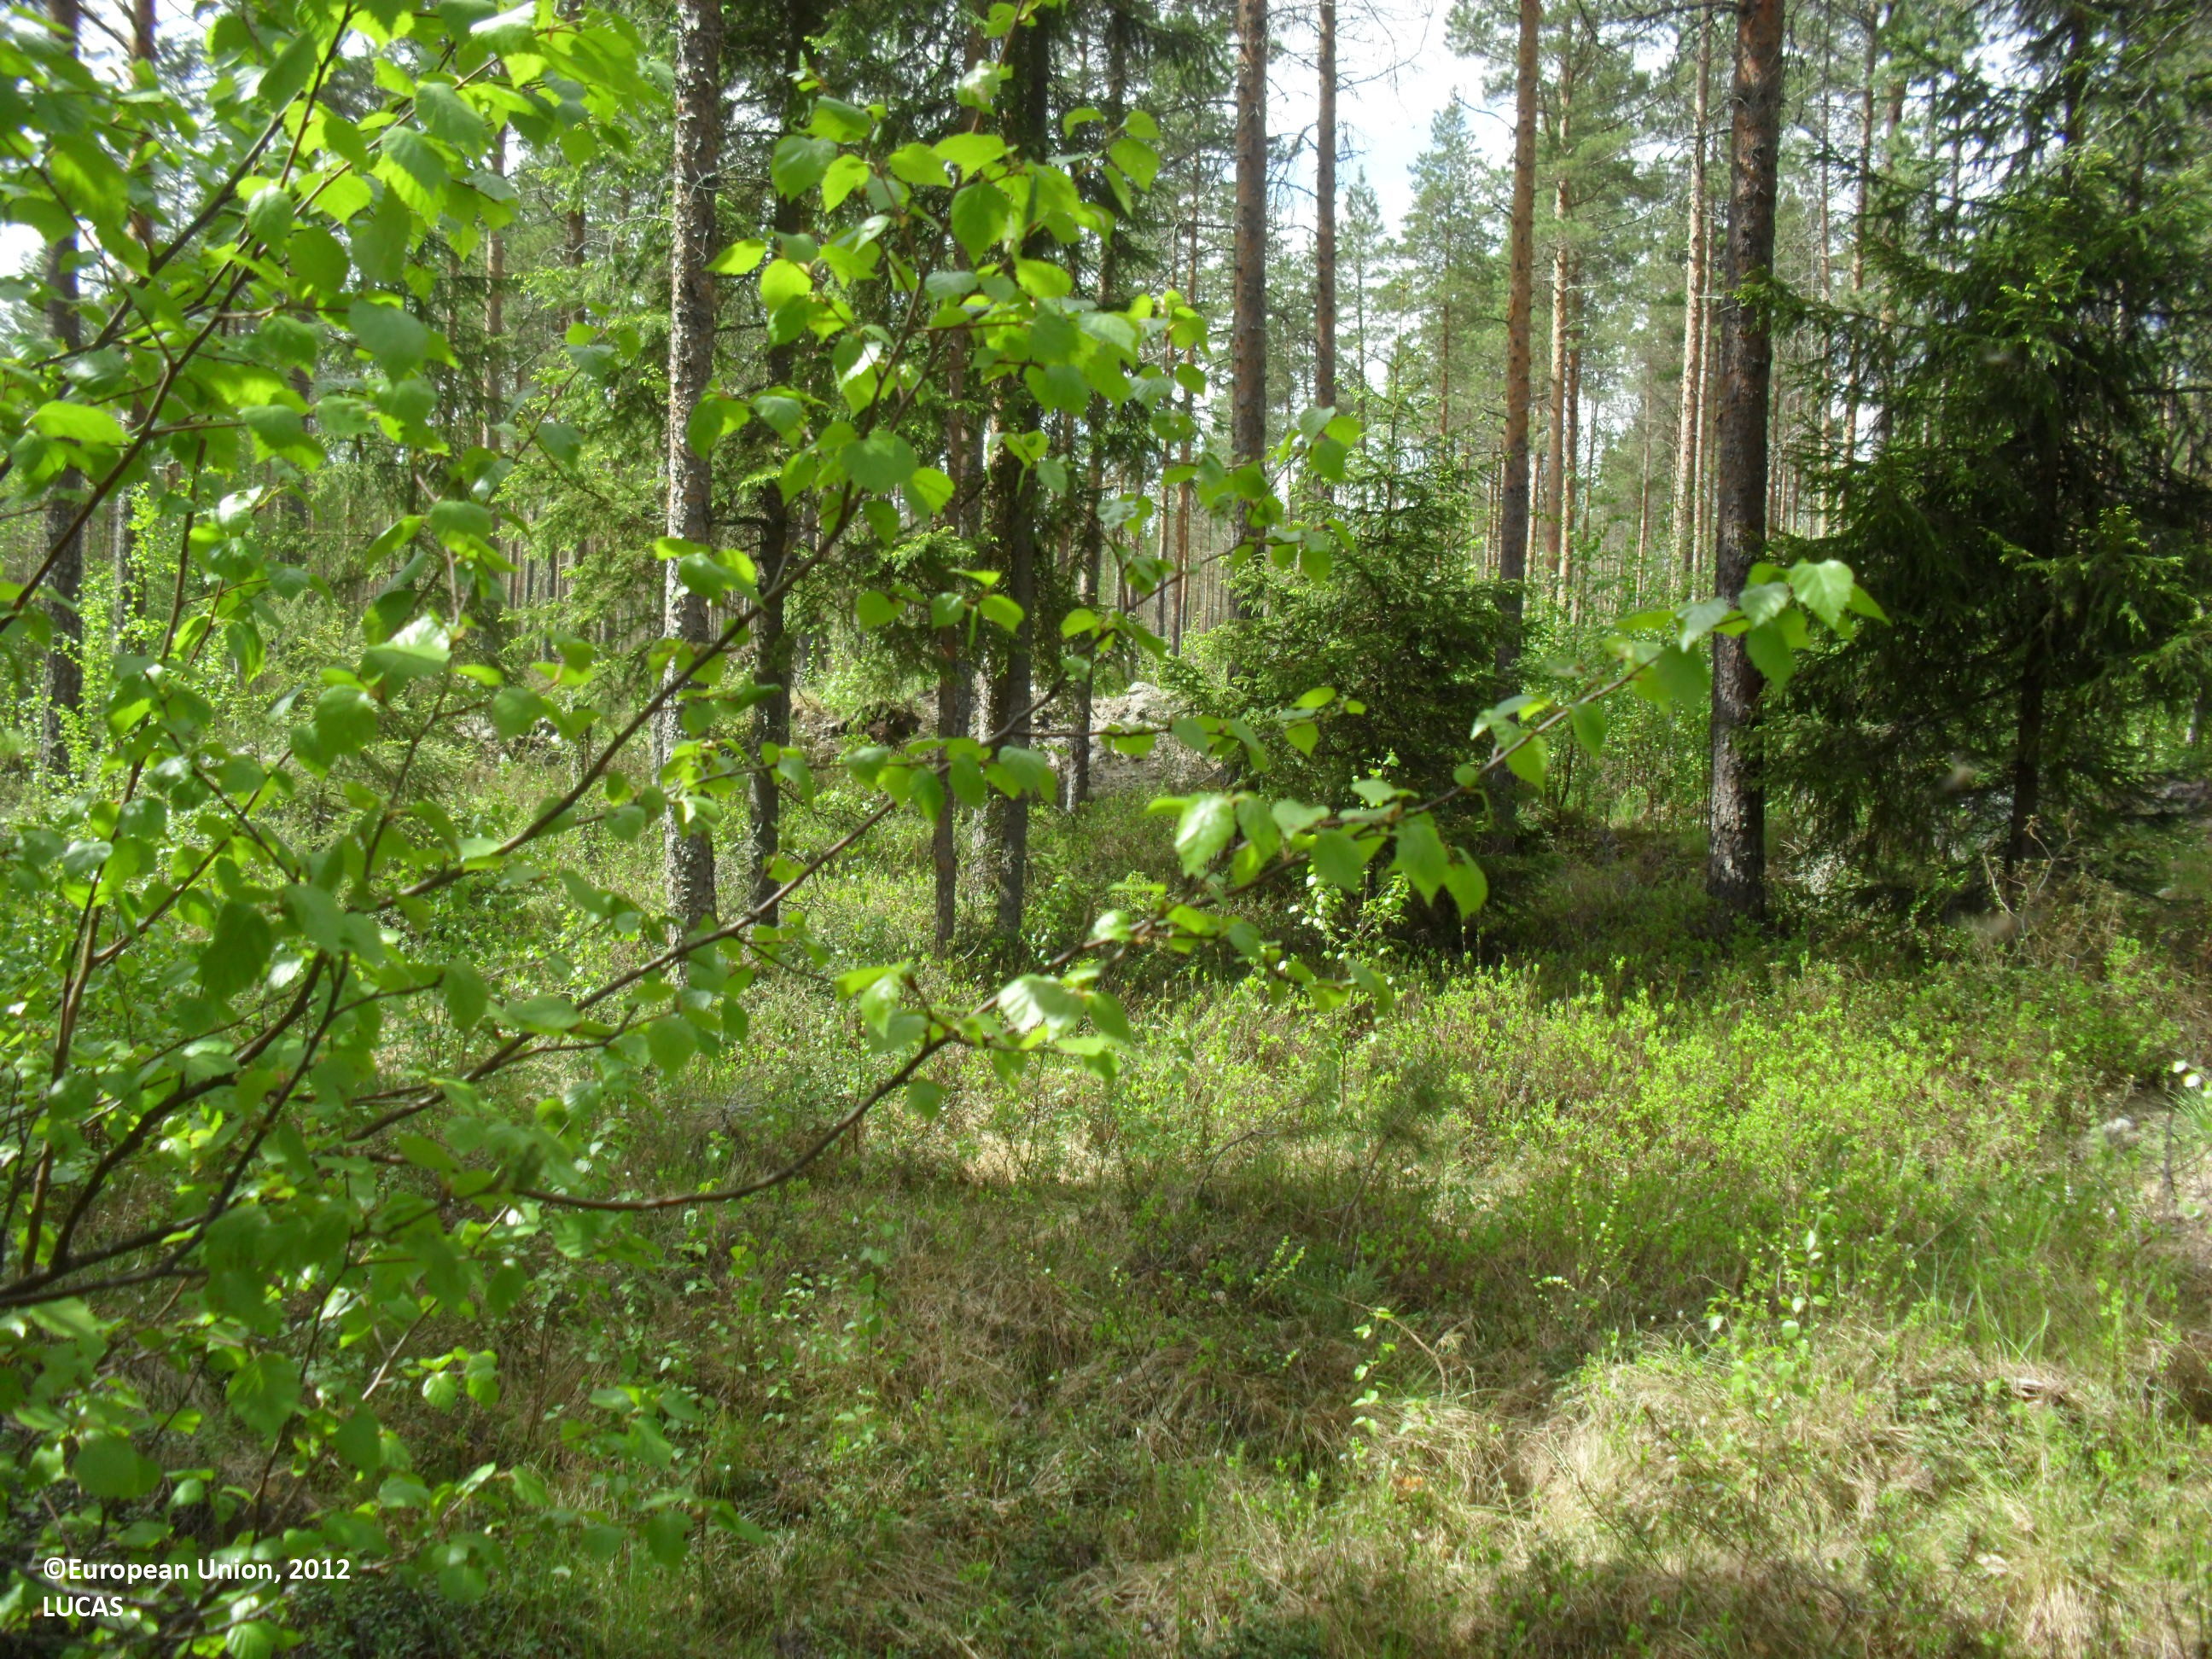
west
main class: Woodland
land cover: Pine dominated coniferous woodland
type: boreal forest
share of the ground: 50 - 75 %
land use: Forestry
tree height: > 5 m
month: June
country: FI
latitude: 63.1417
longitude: 23.2549
